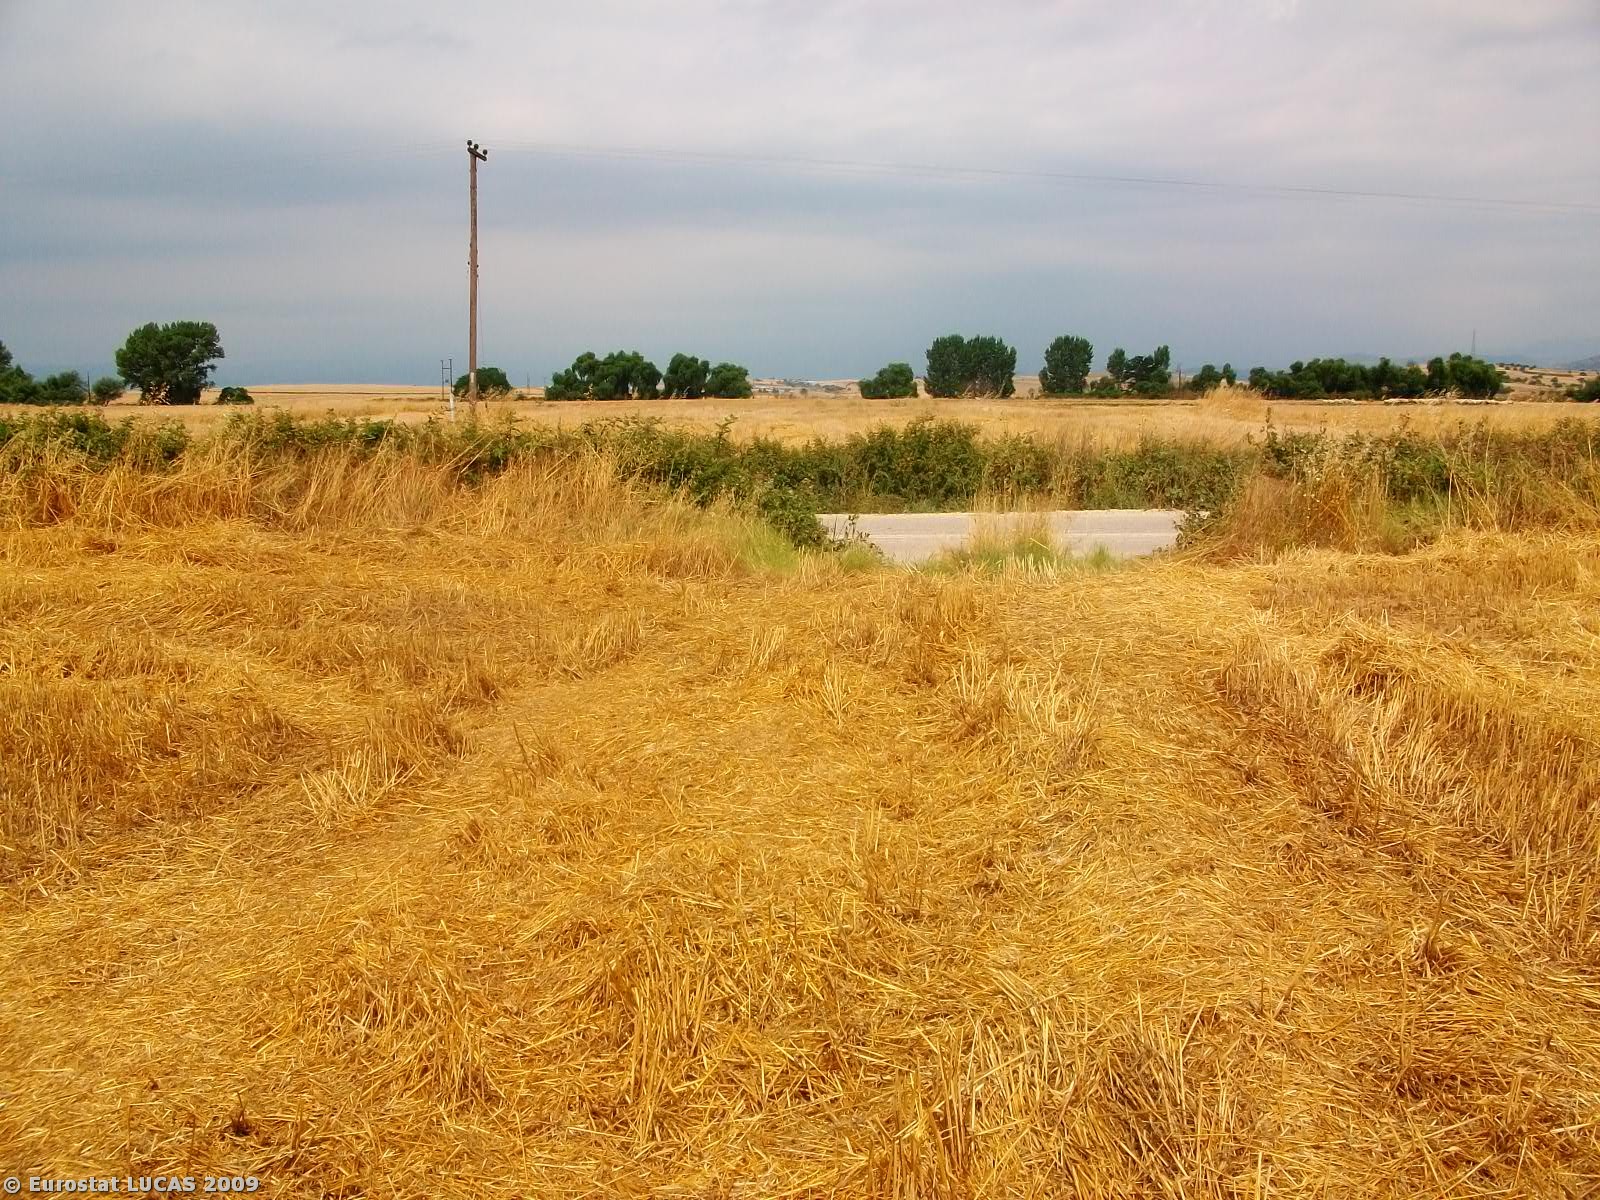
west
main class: Cropland
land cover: Durum wheat
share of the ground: > 75 %
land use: Agriculture (excluding fallow land and kitchen gardens)
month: June
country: GR
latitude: 41.0490
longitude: 23.6433
